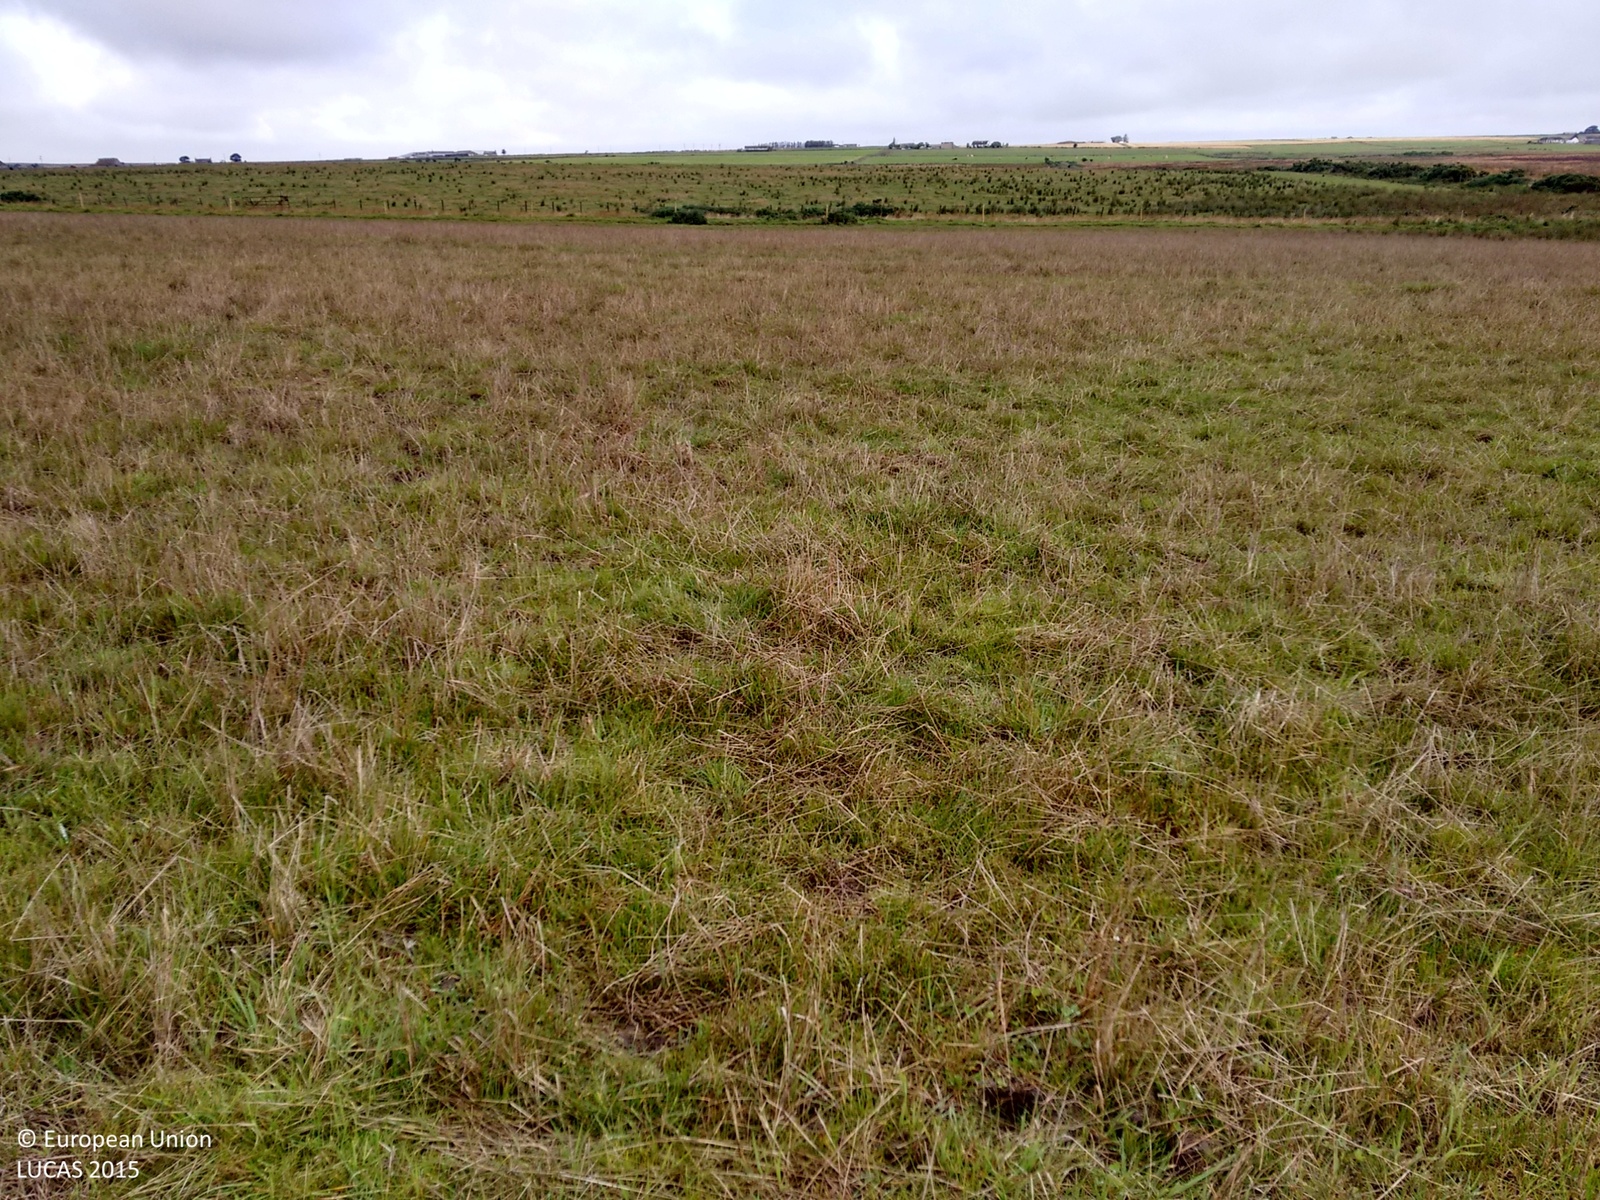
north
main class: Grassland
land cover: Grassland without tree/shrub cover
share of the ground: > 75 %
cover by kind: herbaceous plants 100 %
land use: Agriculture (excluding fallow land and kitchen gardens)
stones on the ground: < 10 %
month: August
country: GB
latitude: 58.4912
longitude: -3.2522
